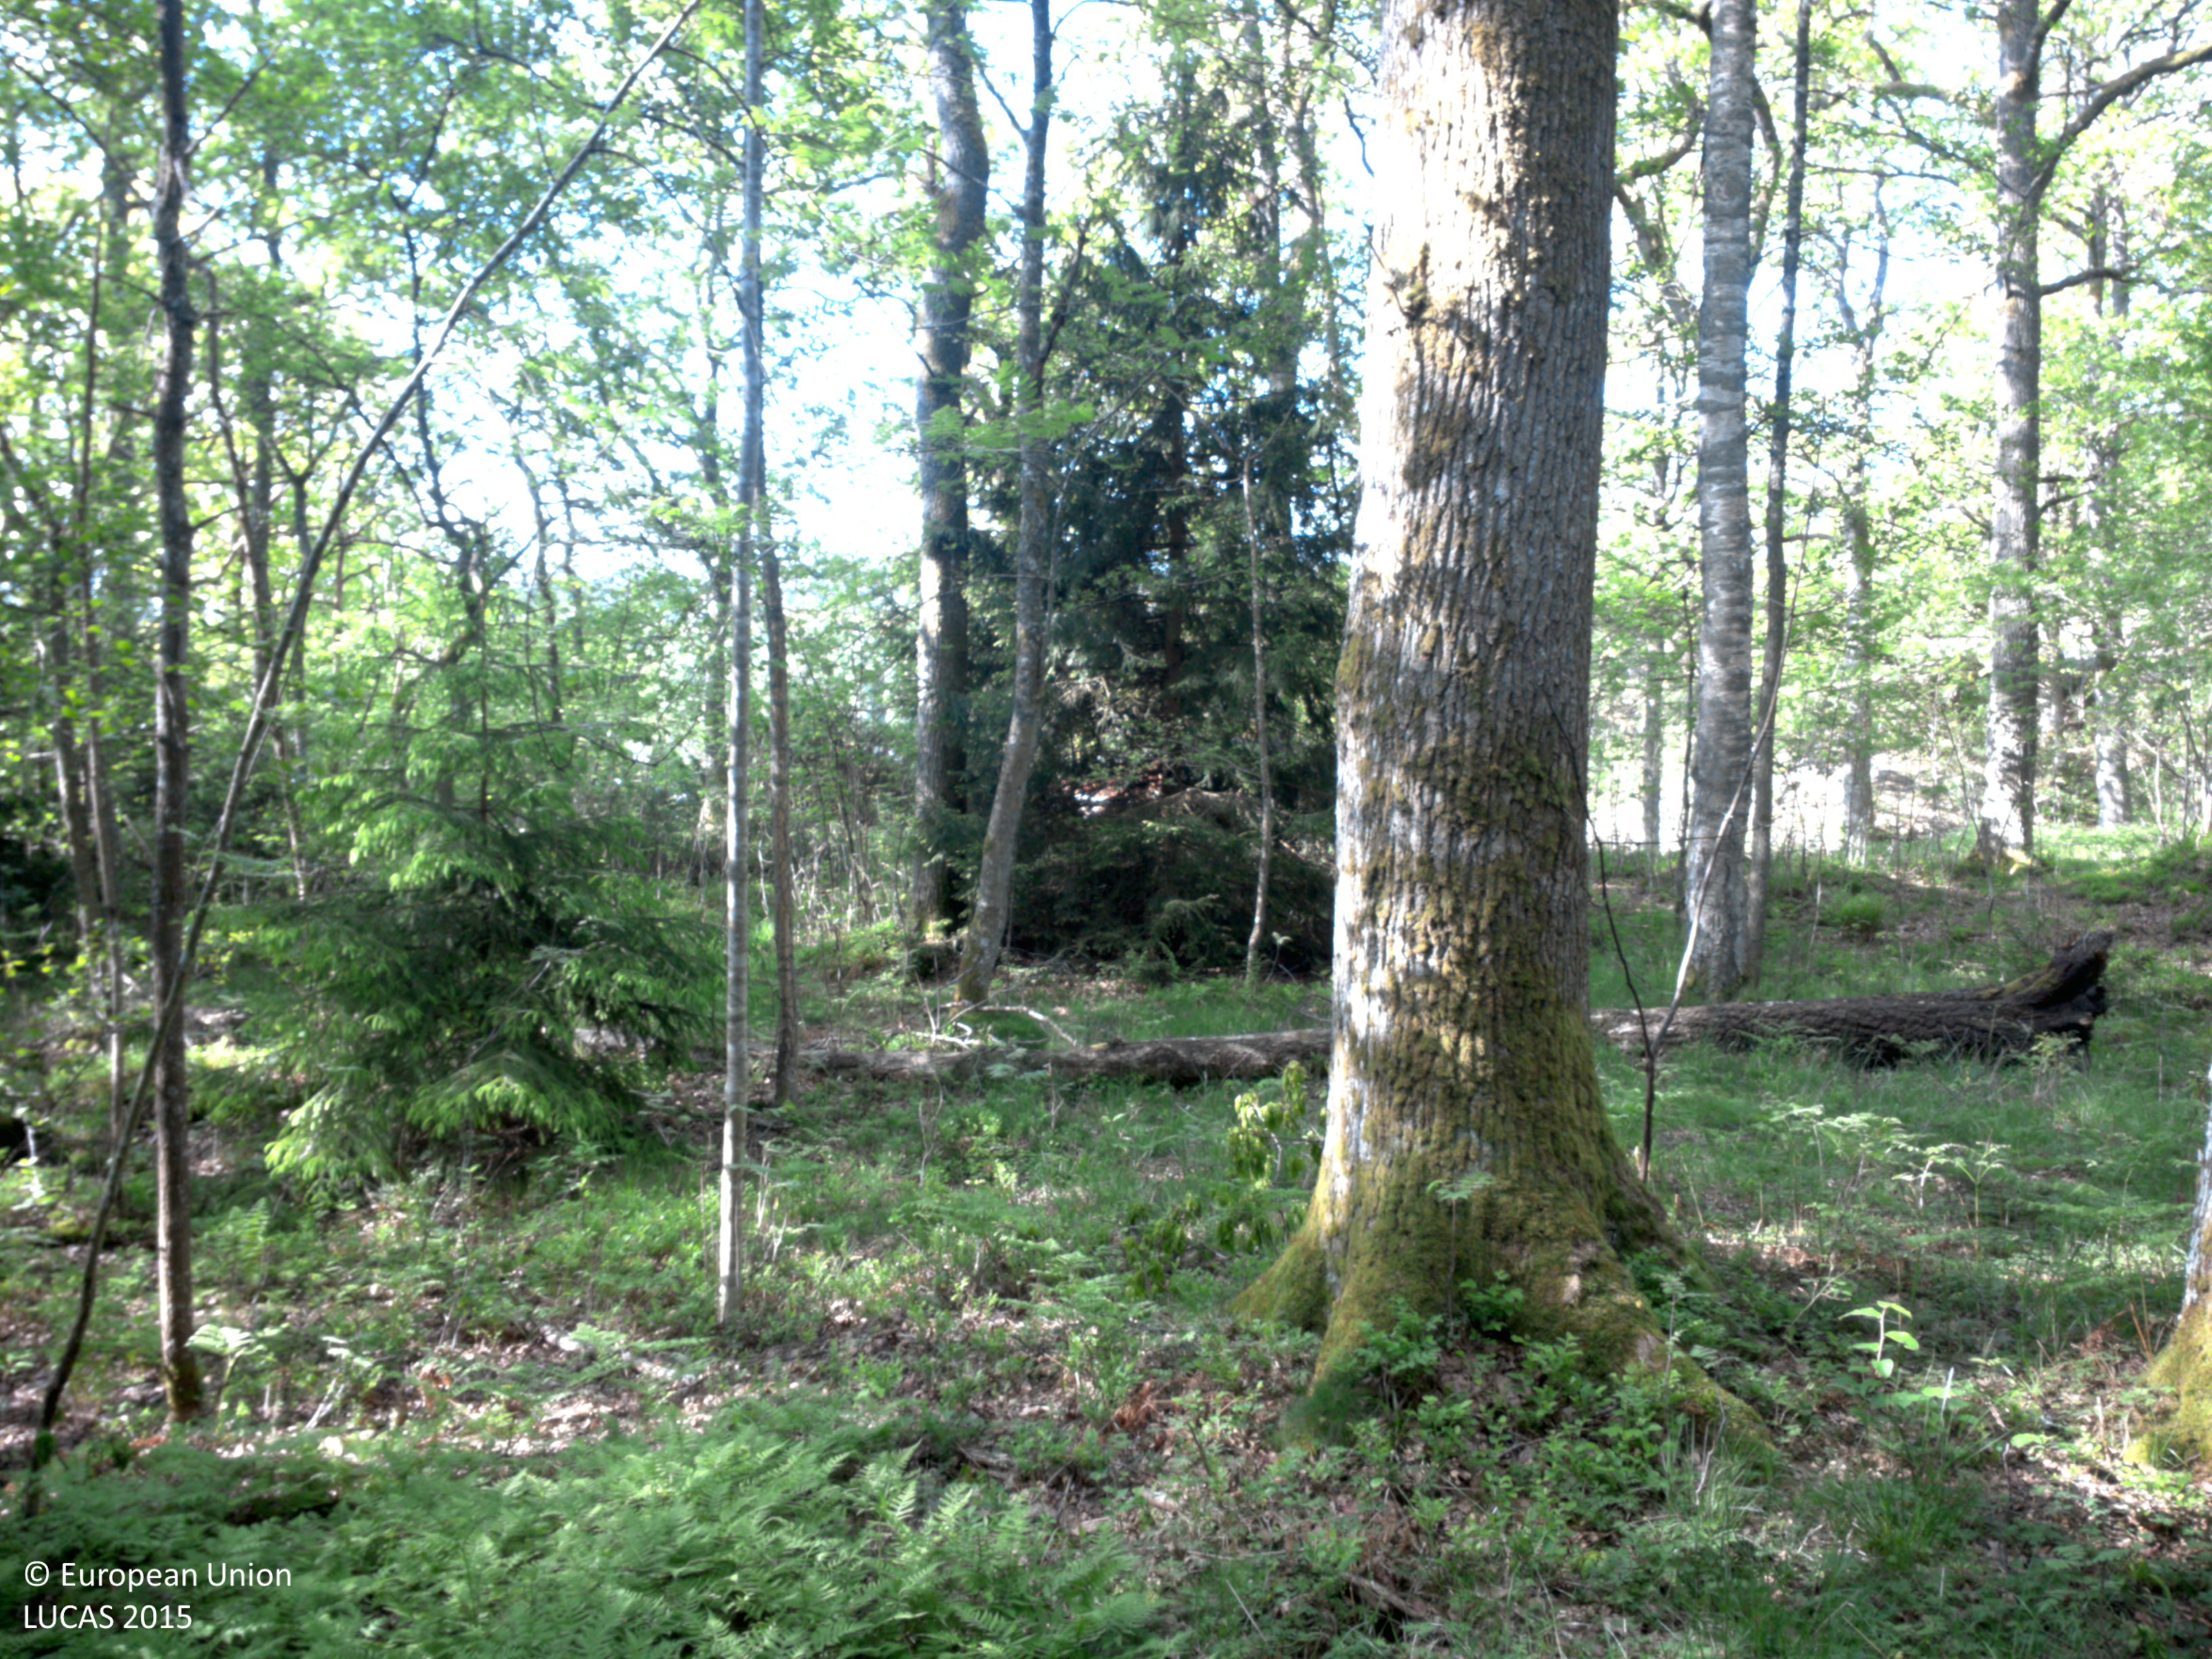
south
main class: Woodland
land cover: Broadleaved woodland
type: mesophytic deciduous forest
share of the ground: 50 - 75 %
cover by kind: broadleaved forest trees 65 %, herbaceous plants 30 %, coniferous forest trees 5 %
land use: Forestry
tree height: > 5 m
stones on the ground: 10 - 25 %
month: June
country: SE
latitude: 58.3506
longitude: 11.8587
